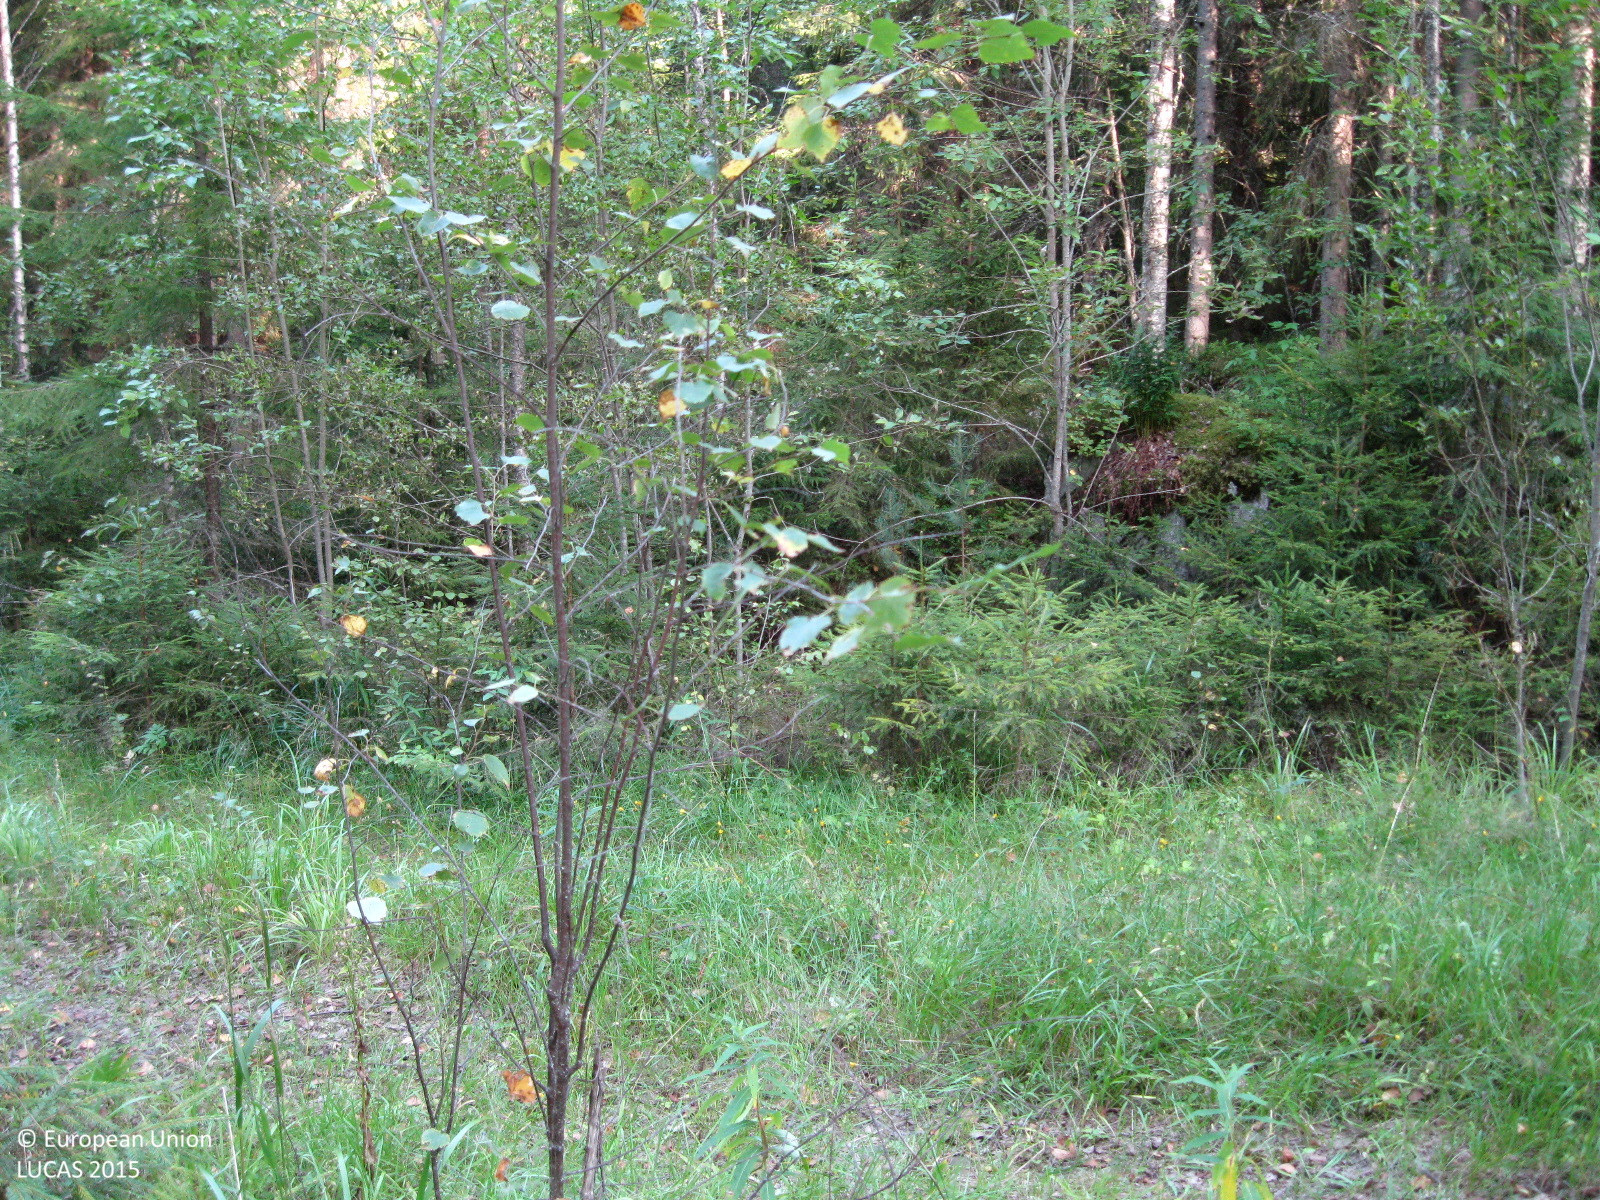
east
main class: Woodland
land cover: Spruce dominated mixed woodland
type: boreal forest
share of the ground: 50 - 75 %
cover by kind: coniferous forest trees 50 %, herbaceous plants 30 %, broadleaved forest trees 20 %
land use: Forestry
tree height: > 5 m
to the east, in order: Tracks; Spruce dominated mixed woodland; Tracks; Pine dominated mixed woodland; Spruce dominated mixed woodland; Spruce dominated coniferous woodland; Broadleaved woodland
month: August
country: FI
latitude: 61.3796
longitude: 25.1414
